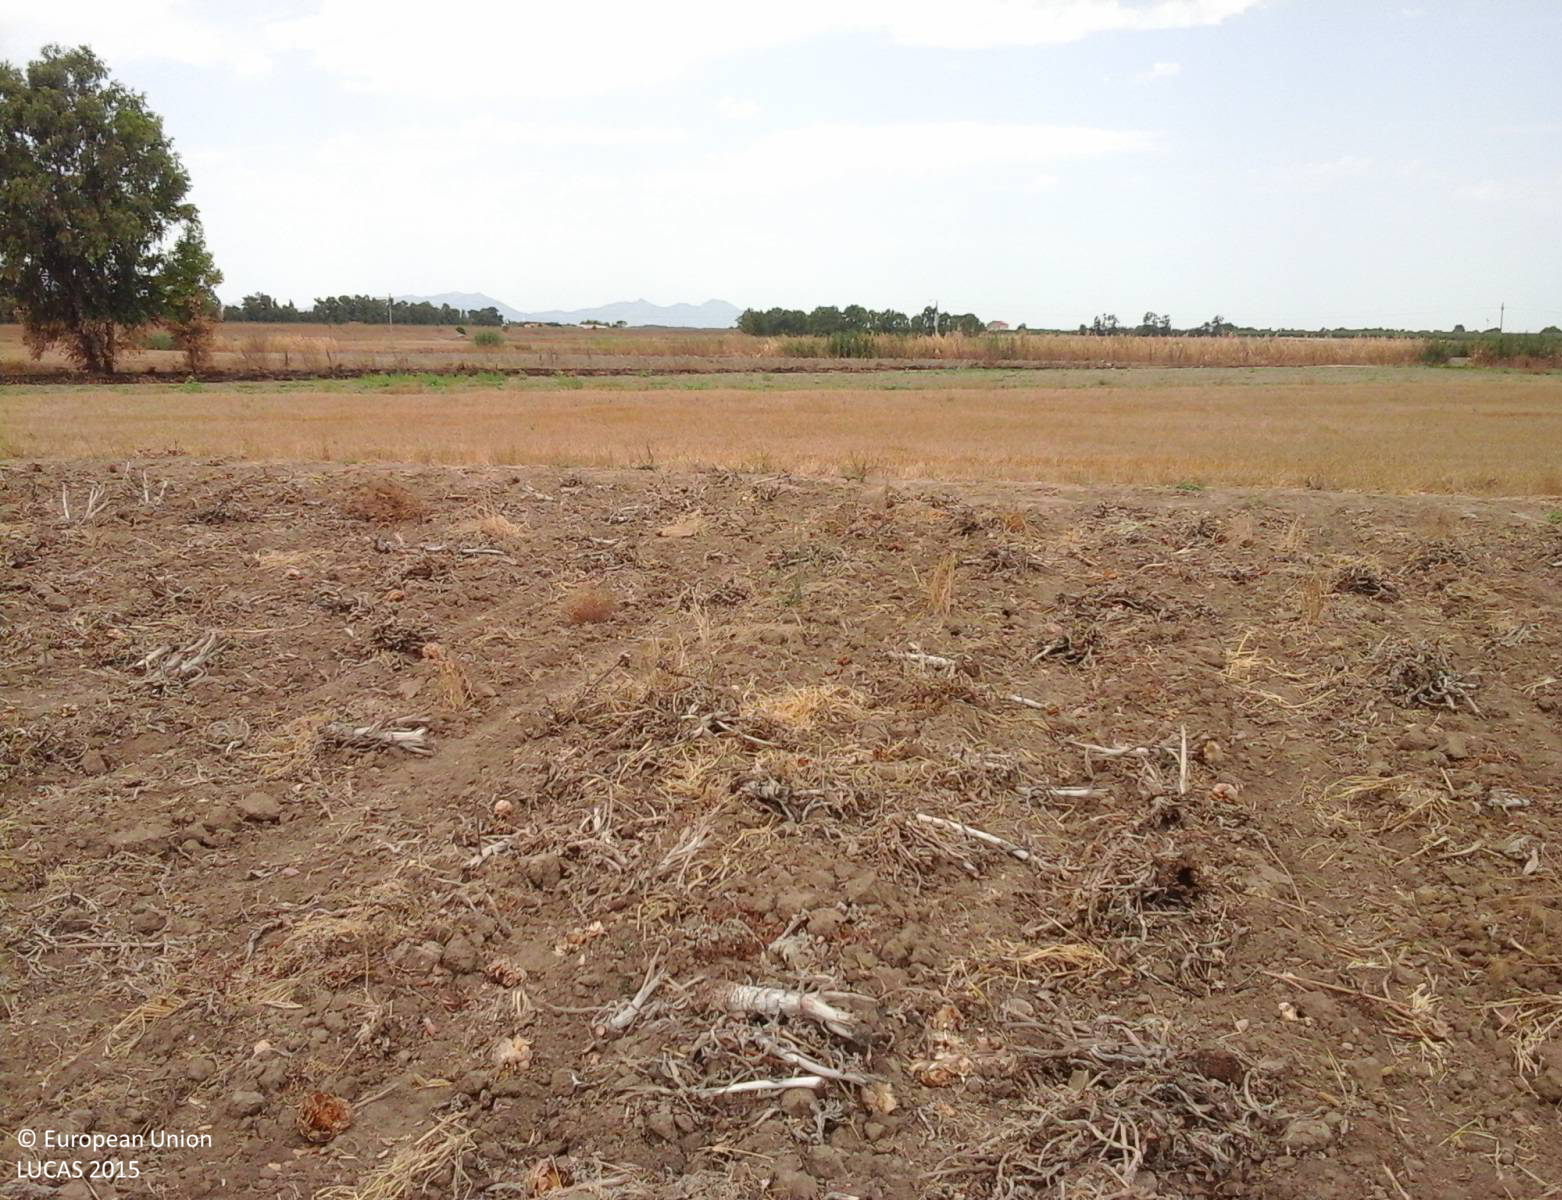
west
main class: Cropland
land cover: Other fresh vegetables
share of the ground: > 75 %
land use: Agriculture (excluding fallow land and kitchen gardens)
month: July
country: IT
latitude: 39.4821
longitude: 8.8790
